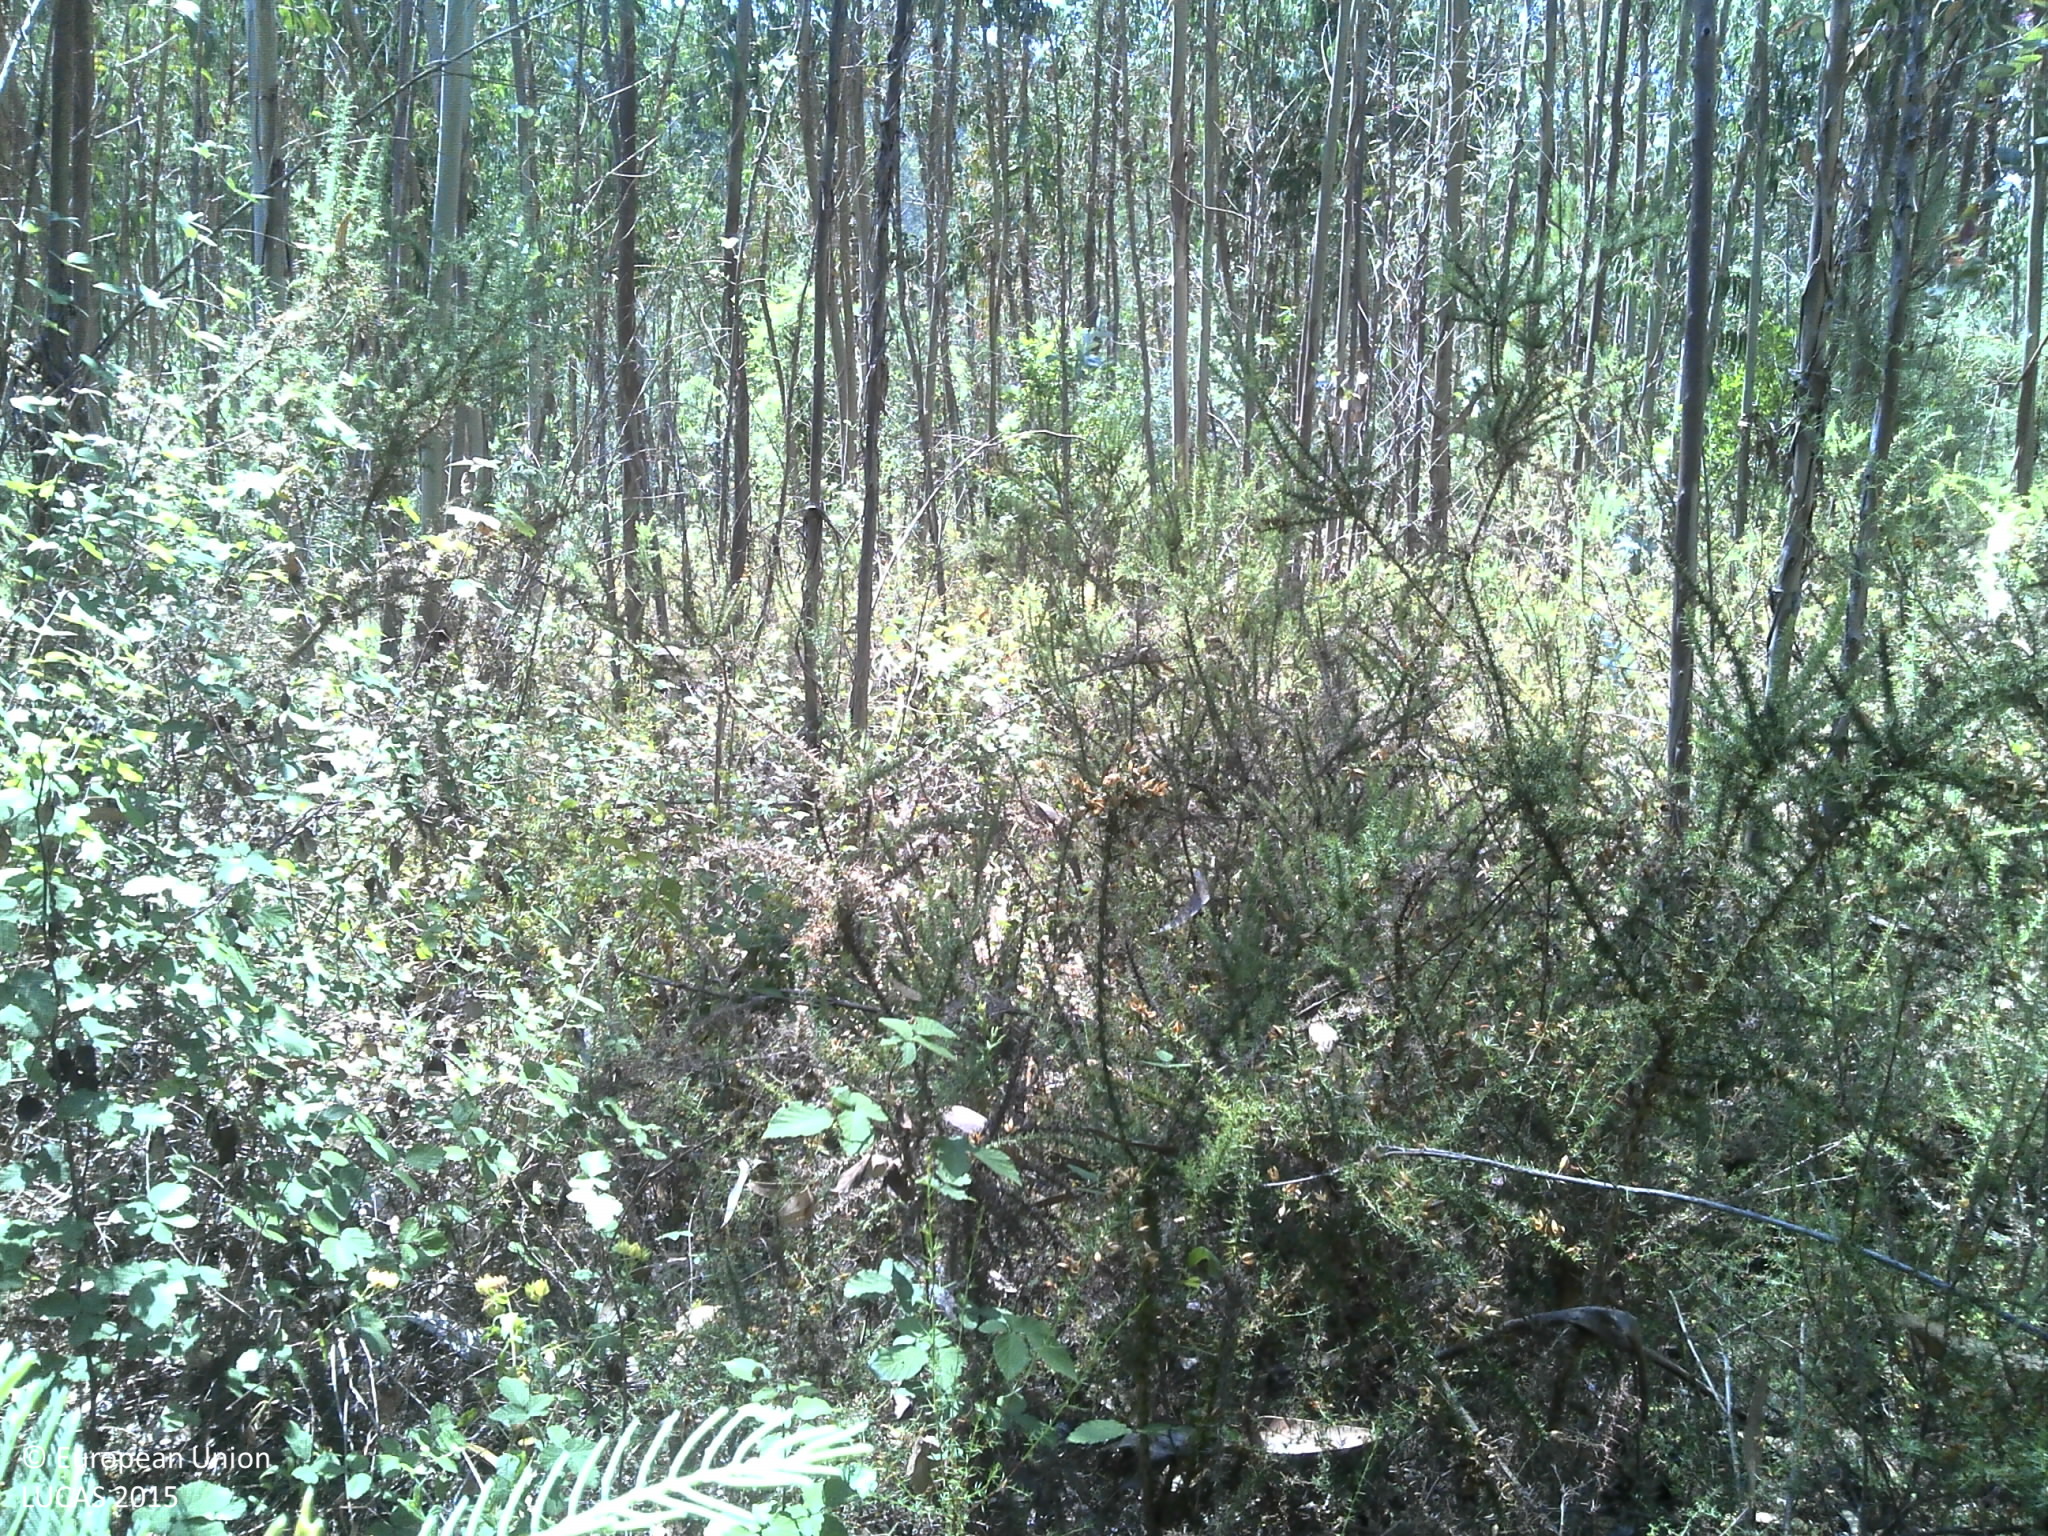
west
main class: Woodland
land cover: Broadleaved woodland
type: exotic forest
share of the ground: > 75 %
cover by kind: broadleaved forest trees 75 %, shrubs 15 %, unconsolidated bare surface 10 %
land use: Forestry
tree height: > 5 m
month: July
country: PT
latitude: 40.2112
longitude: -8.2070
